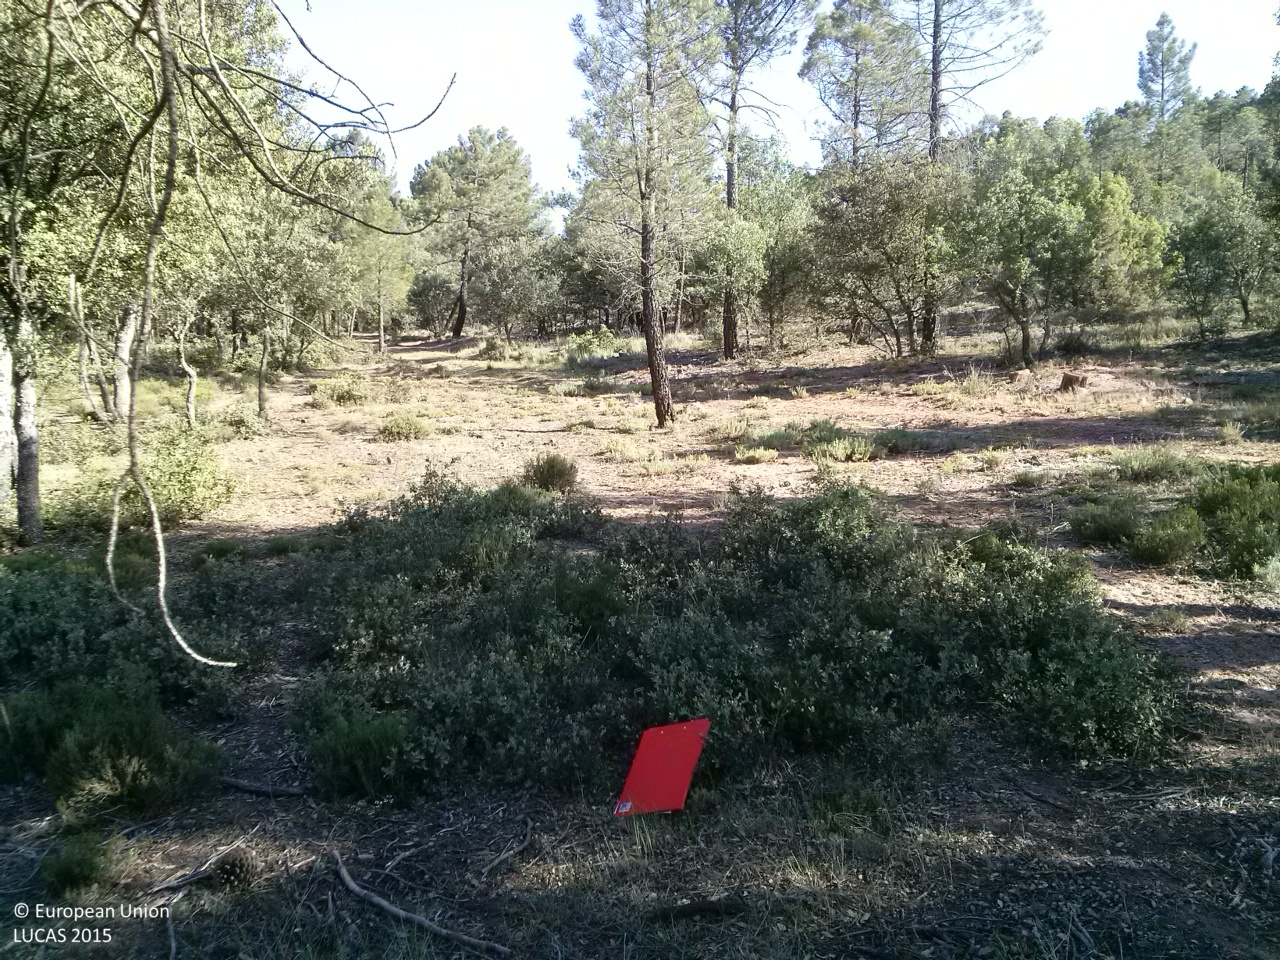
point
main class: Woodland
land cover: Other mixed woodland
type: broadleaved evergreen forest
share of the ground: 10 - 25 %
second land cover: Shrubland without tree cover
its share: 10 - 25 %
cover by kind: shrubs 25 %, herbaceous plants 25 %, unconsolidated bare surface 25 %, broadleaved forest trees 15 %, coniferous forest trees 10 %
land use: Forestry
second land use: Agriculture (excluding fallow land and kitchen gardens)
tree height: > 5 m
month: June
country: ES
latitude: 39.9506
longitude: -1.6803
